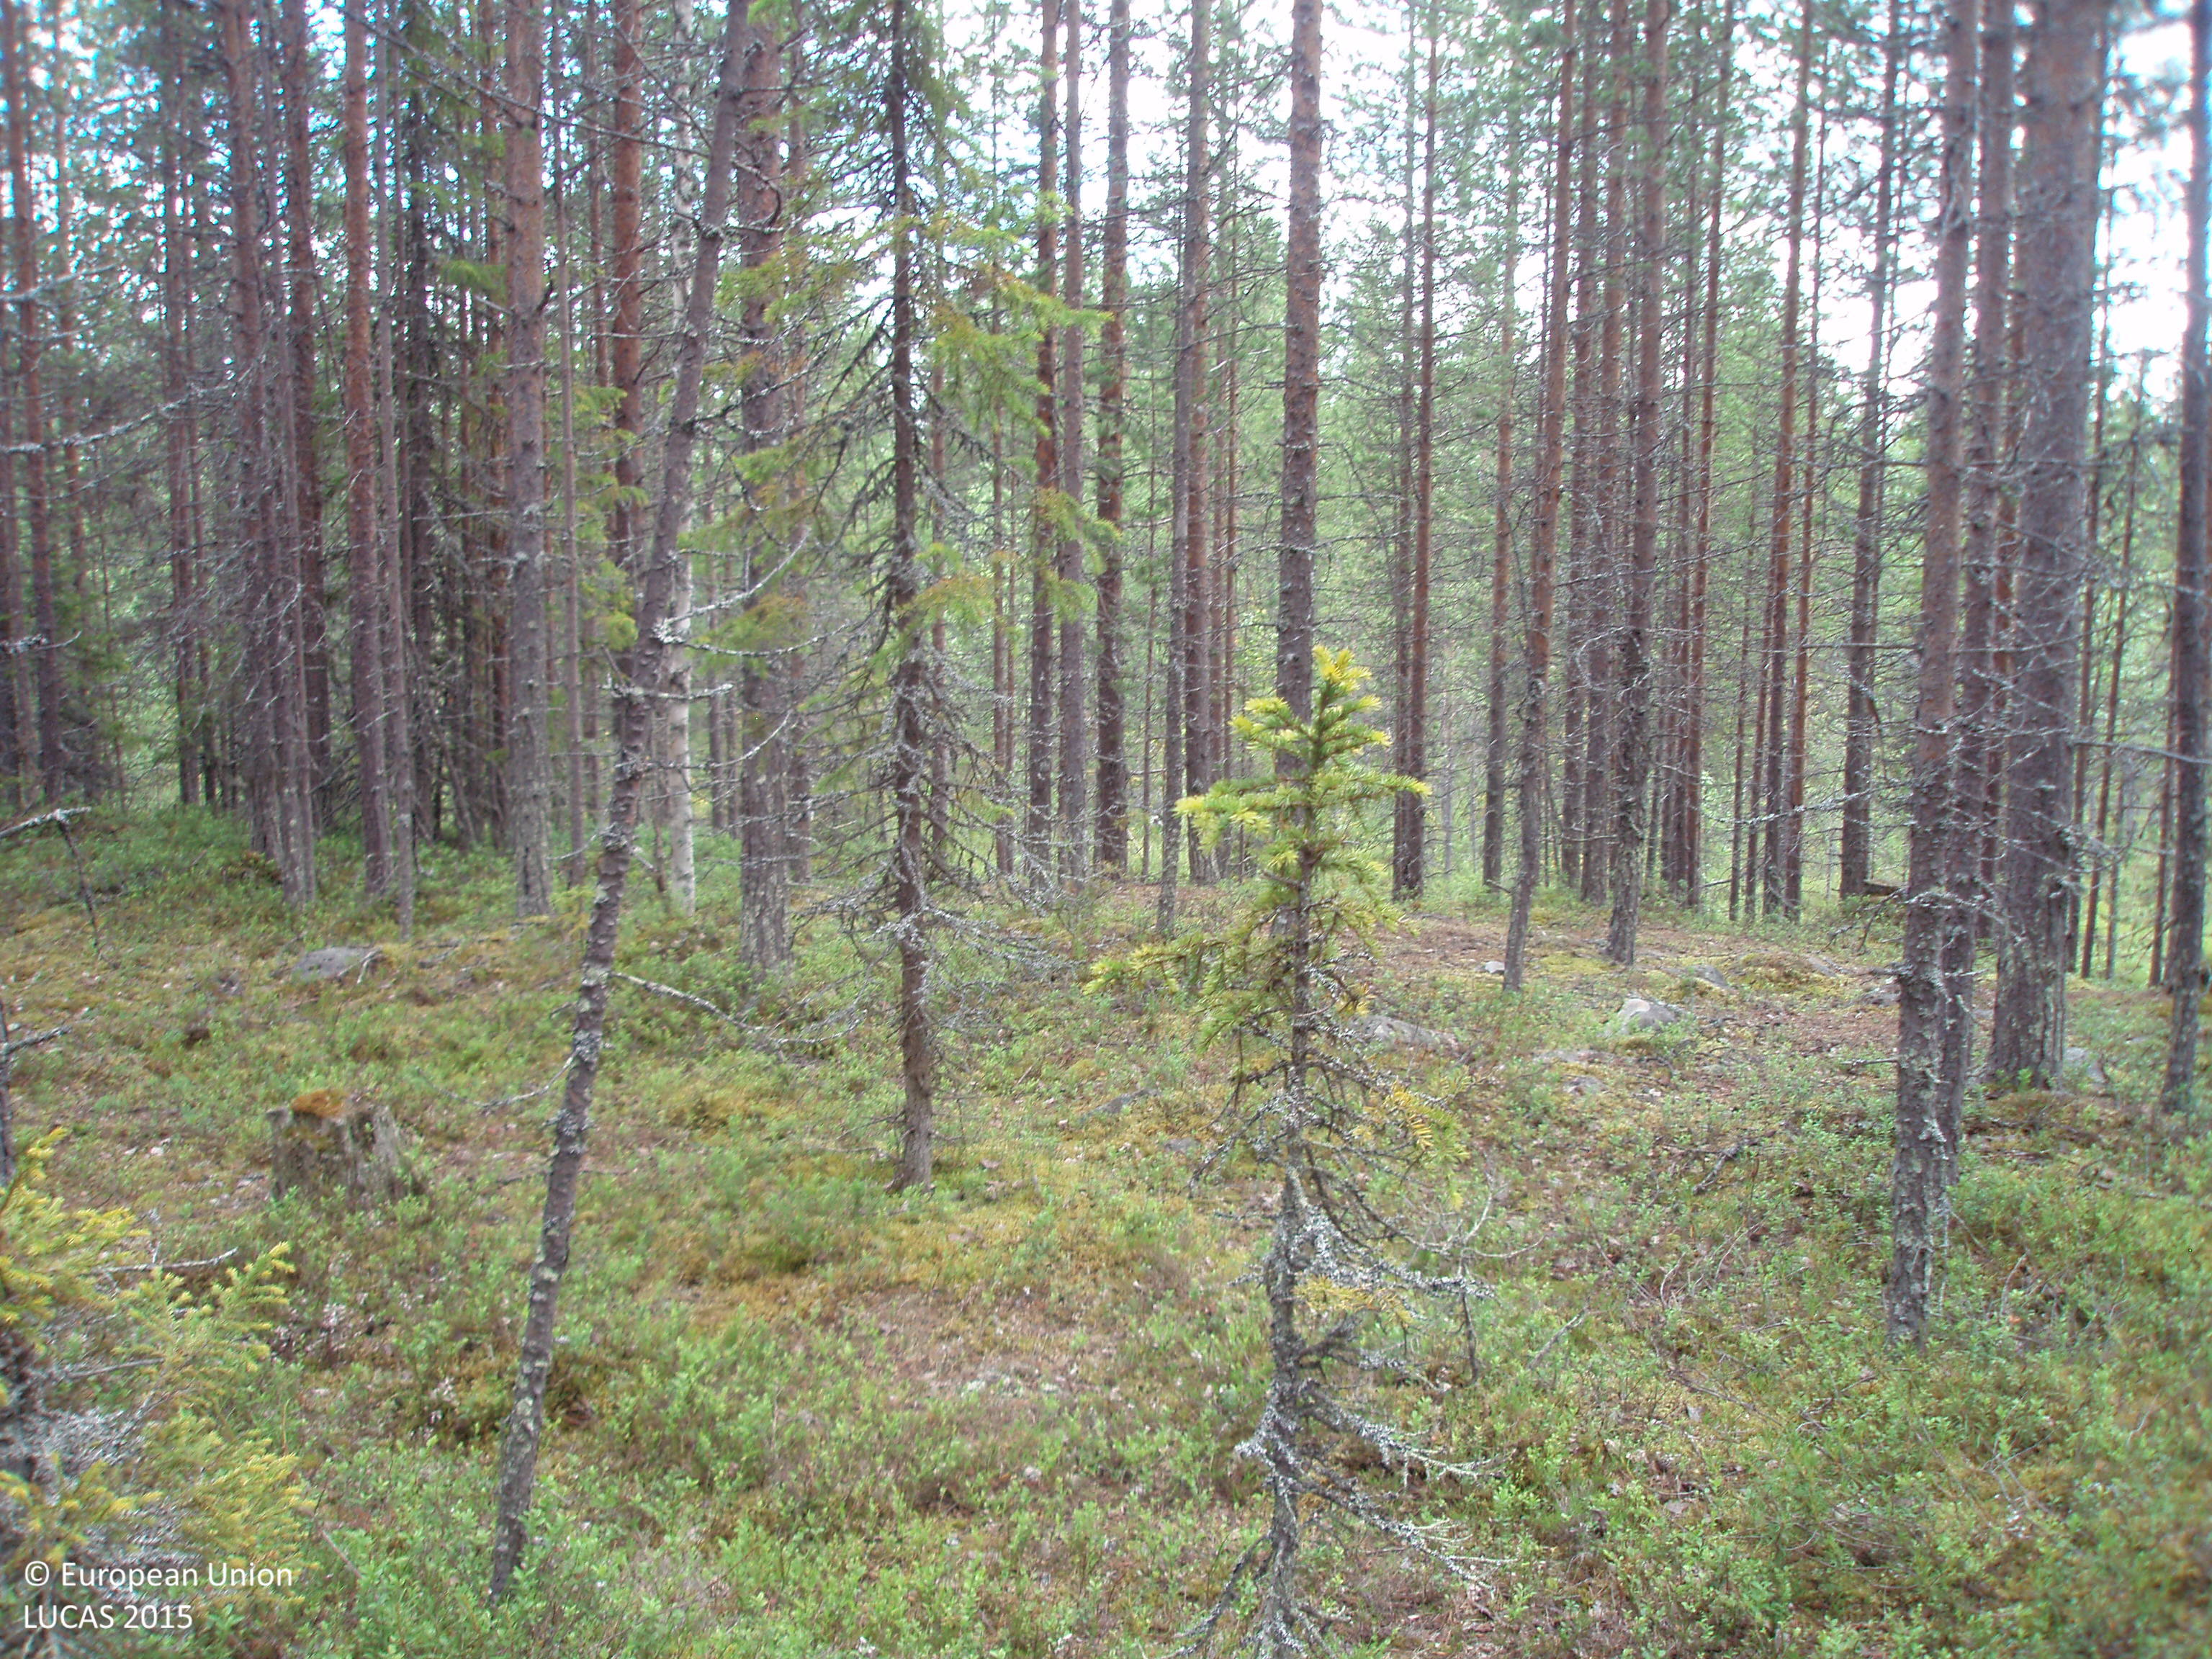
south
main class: Woodland
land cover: Pine dominated coniferous woodland
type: boreal forest
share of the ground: > 75 %
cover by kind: coniferous forest trees 70 %, shrubs 20 %, broadleaved forest trees 5 %, lichens and mosses 5 %
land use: Forestry
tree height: > 5 m
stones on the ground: 10 - 25 %
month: July
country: FI
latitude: 66.8945
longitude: 28.4282
